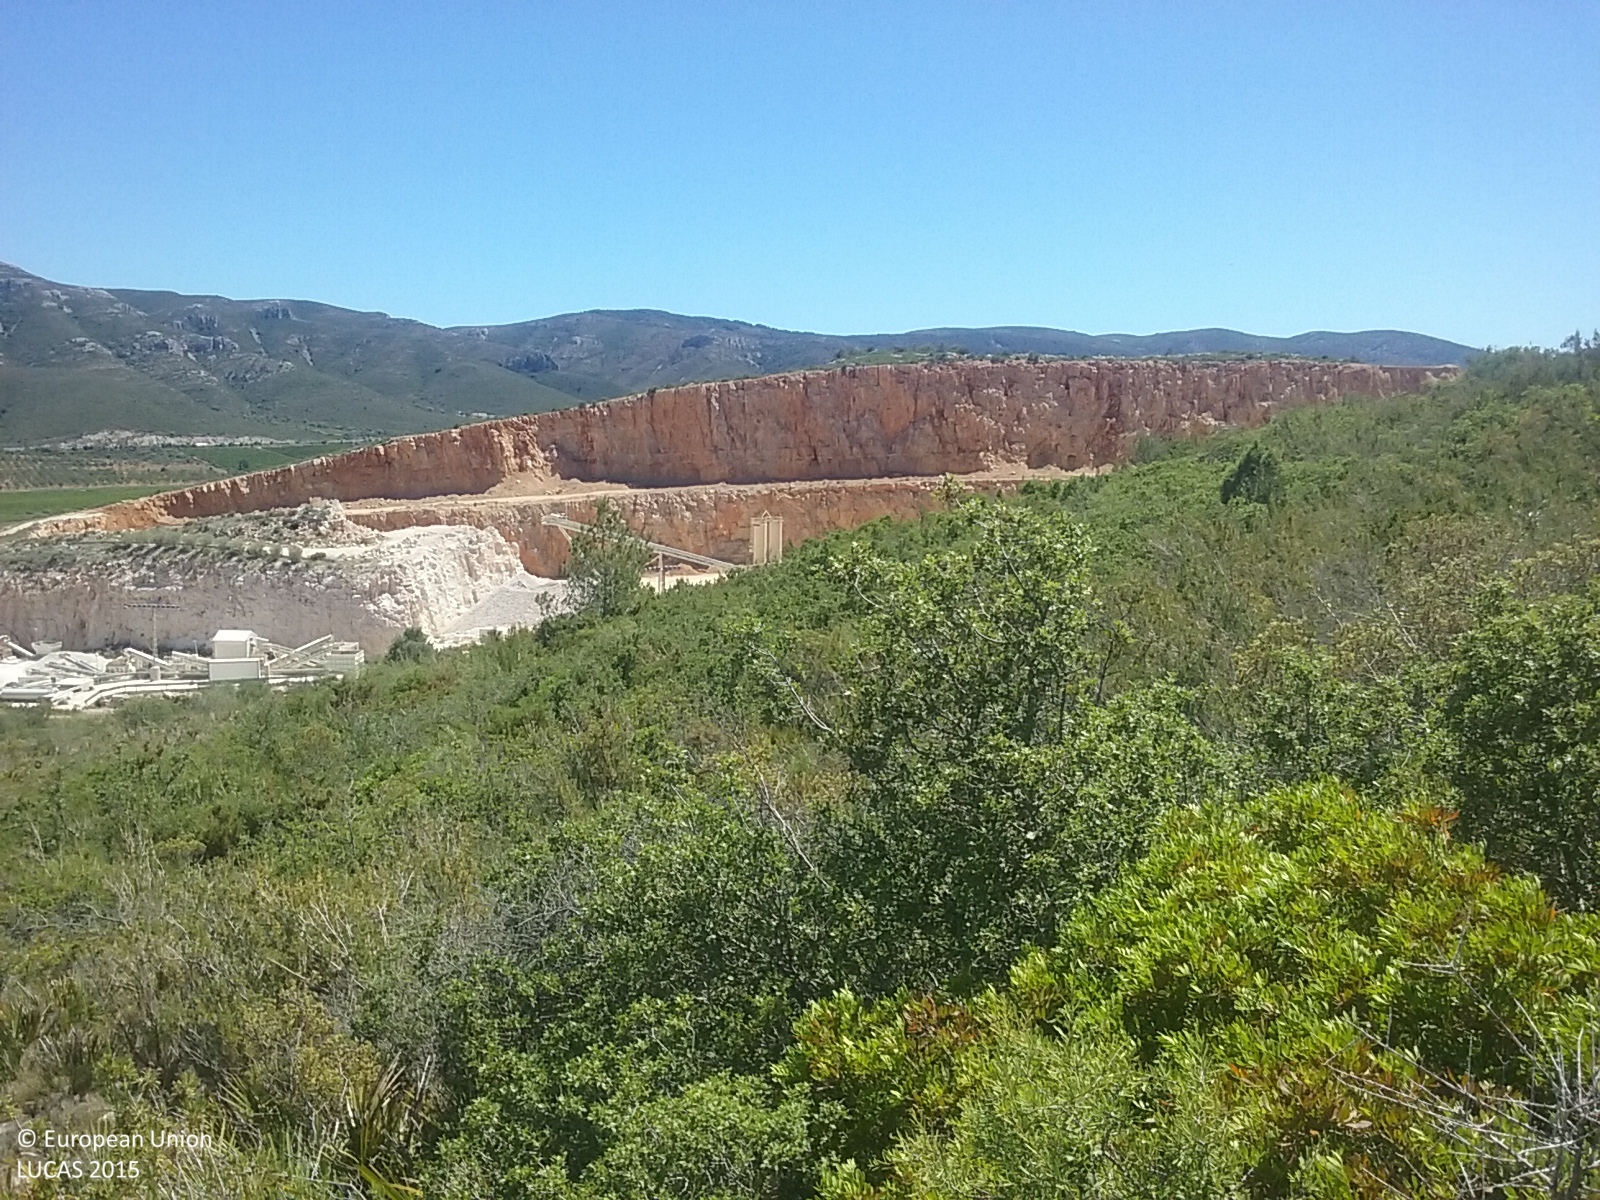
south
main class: Shrubland
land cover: Shrubland with sparse tree cover
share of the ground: > 75 %
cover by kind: shrubs 90 %, broadleaved forest trees 5 %
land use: Semi-natural and natural areas not in use
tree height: < 5 m
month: May
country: ES
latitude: 40.3890
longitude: 0.3251
